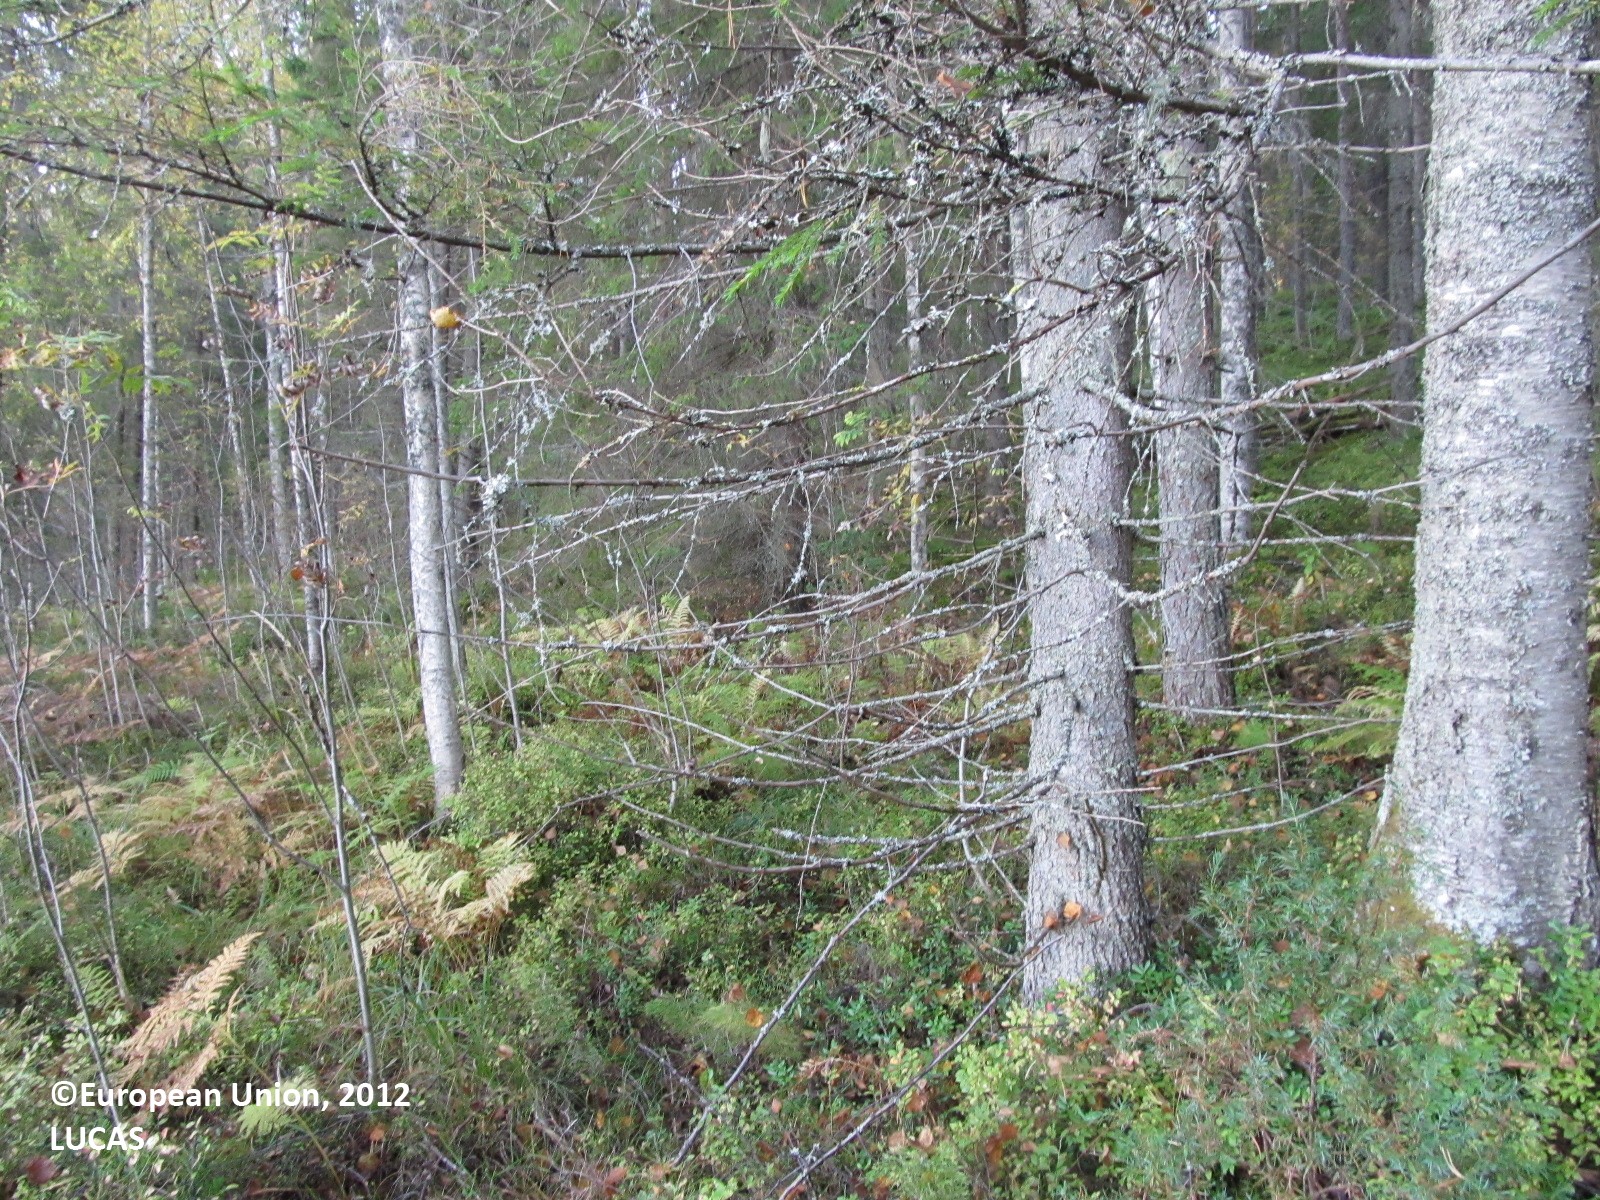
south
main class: Woodland
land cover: Spruce dominated mixed woodland
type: boreal forest
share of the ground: 25 - 50 %
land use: Forestry
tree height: > 5 m
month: September
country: FI
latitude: 62.3739
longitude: 28.5496
